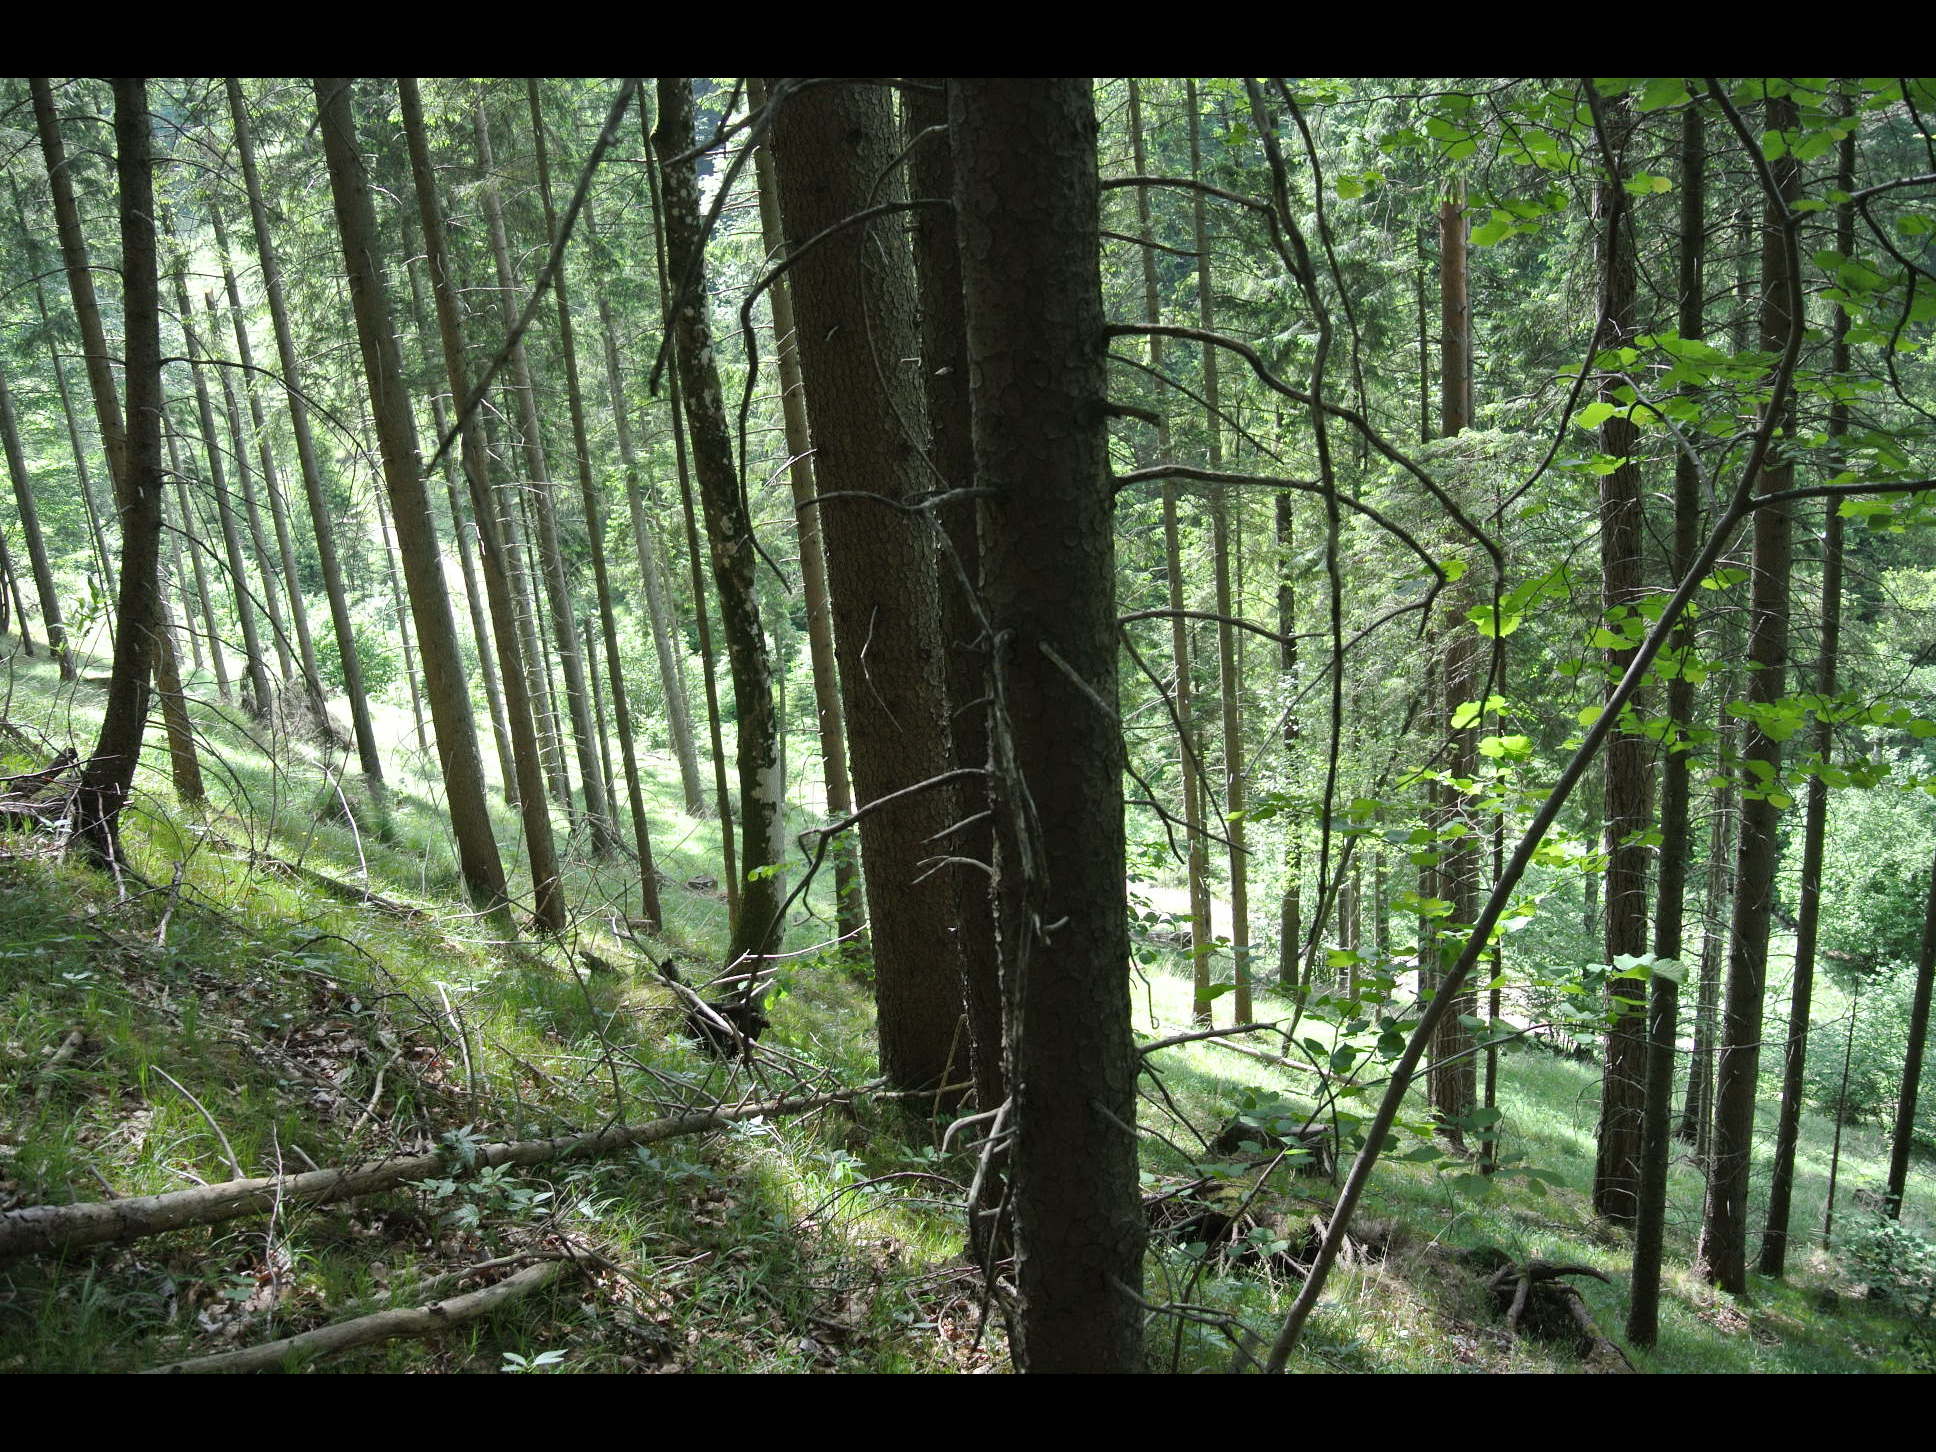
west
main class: Woodland
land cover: Spruce dominated mixed woodland
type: alpine coniferous forest
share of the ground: > 75 %
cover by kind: coniferous forest trees 75 %, broadleaved forest trees 25 %
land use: Forestry
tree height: > 5 m
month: May
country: AT
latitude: 47.9460
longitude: 15.7731
